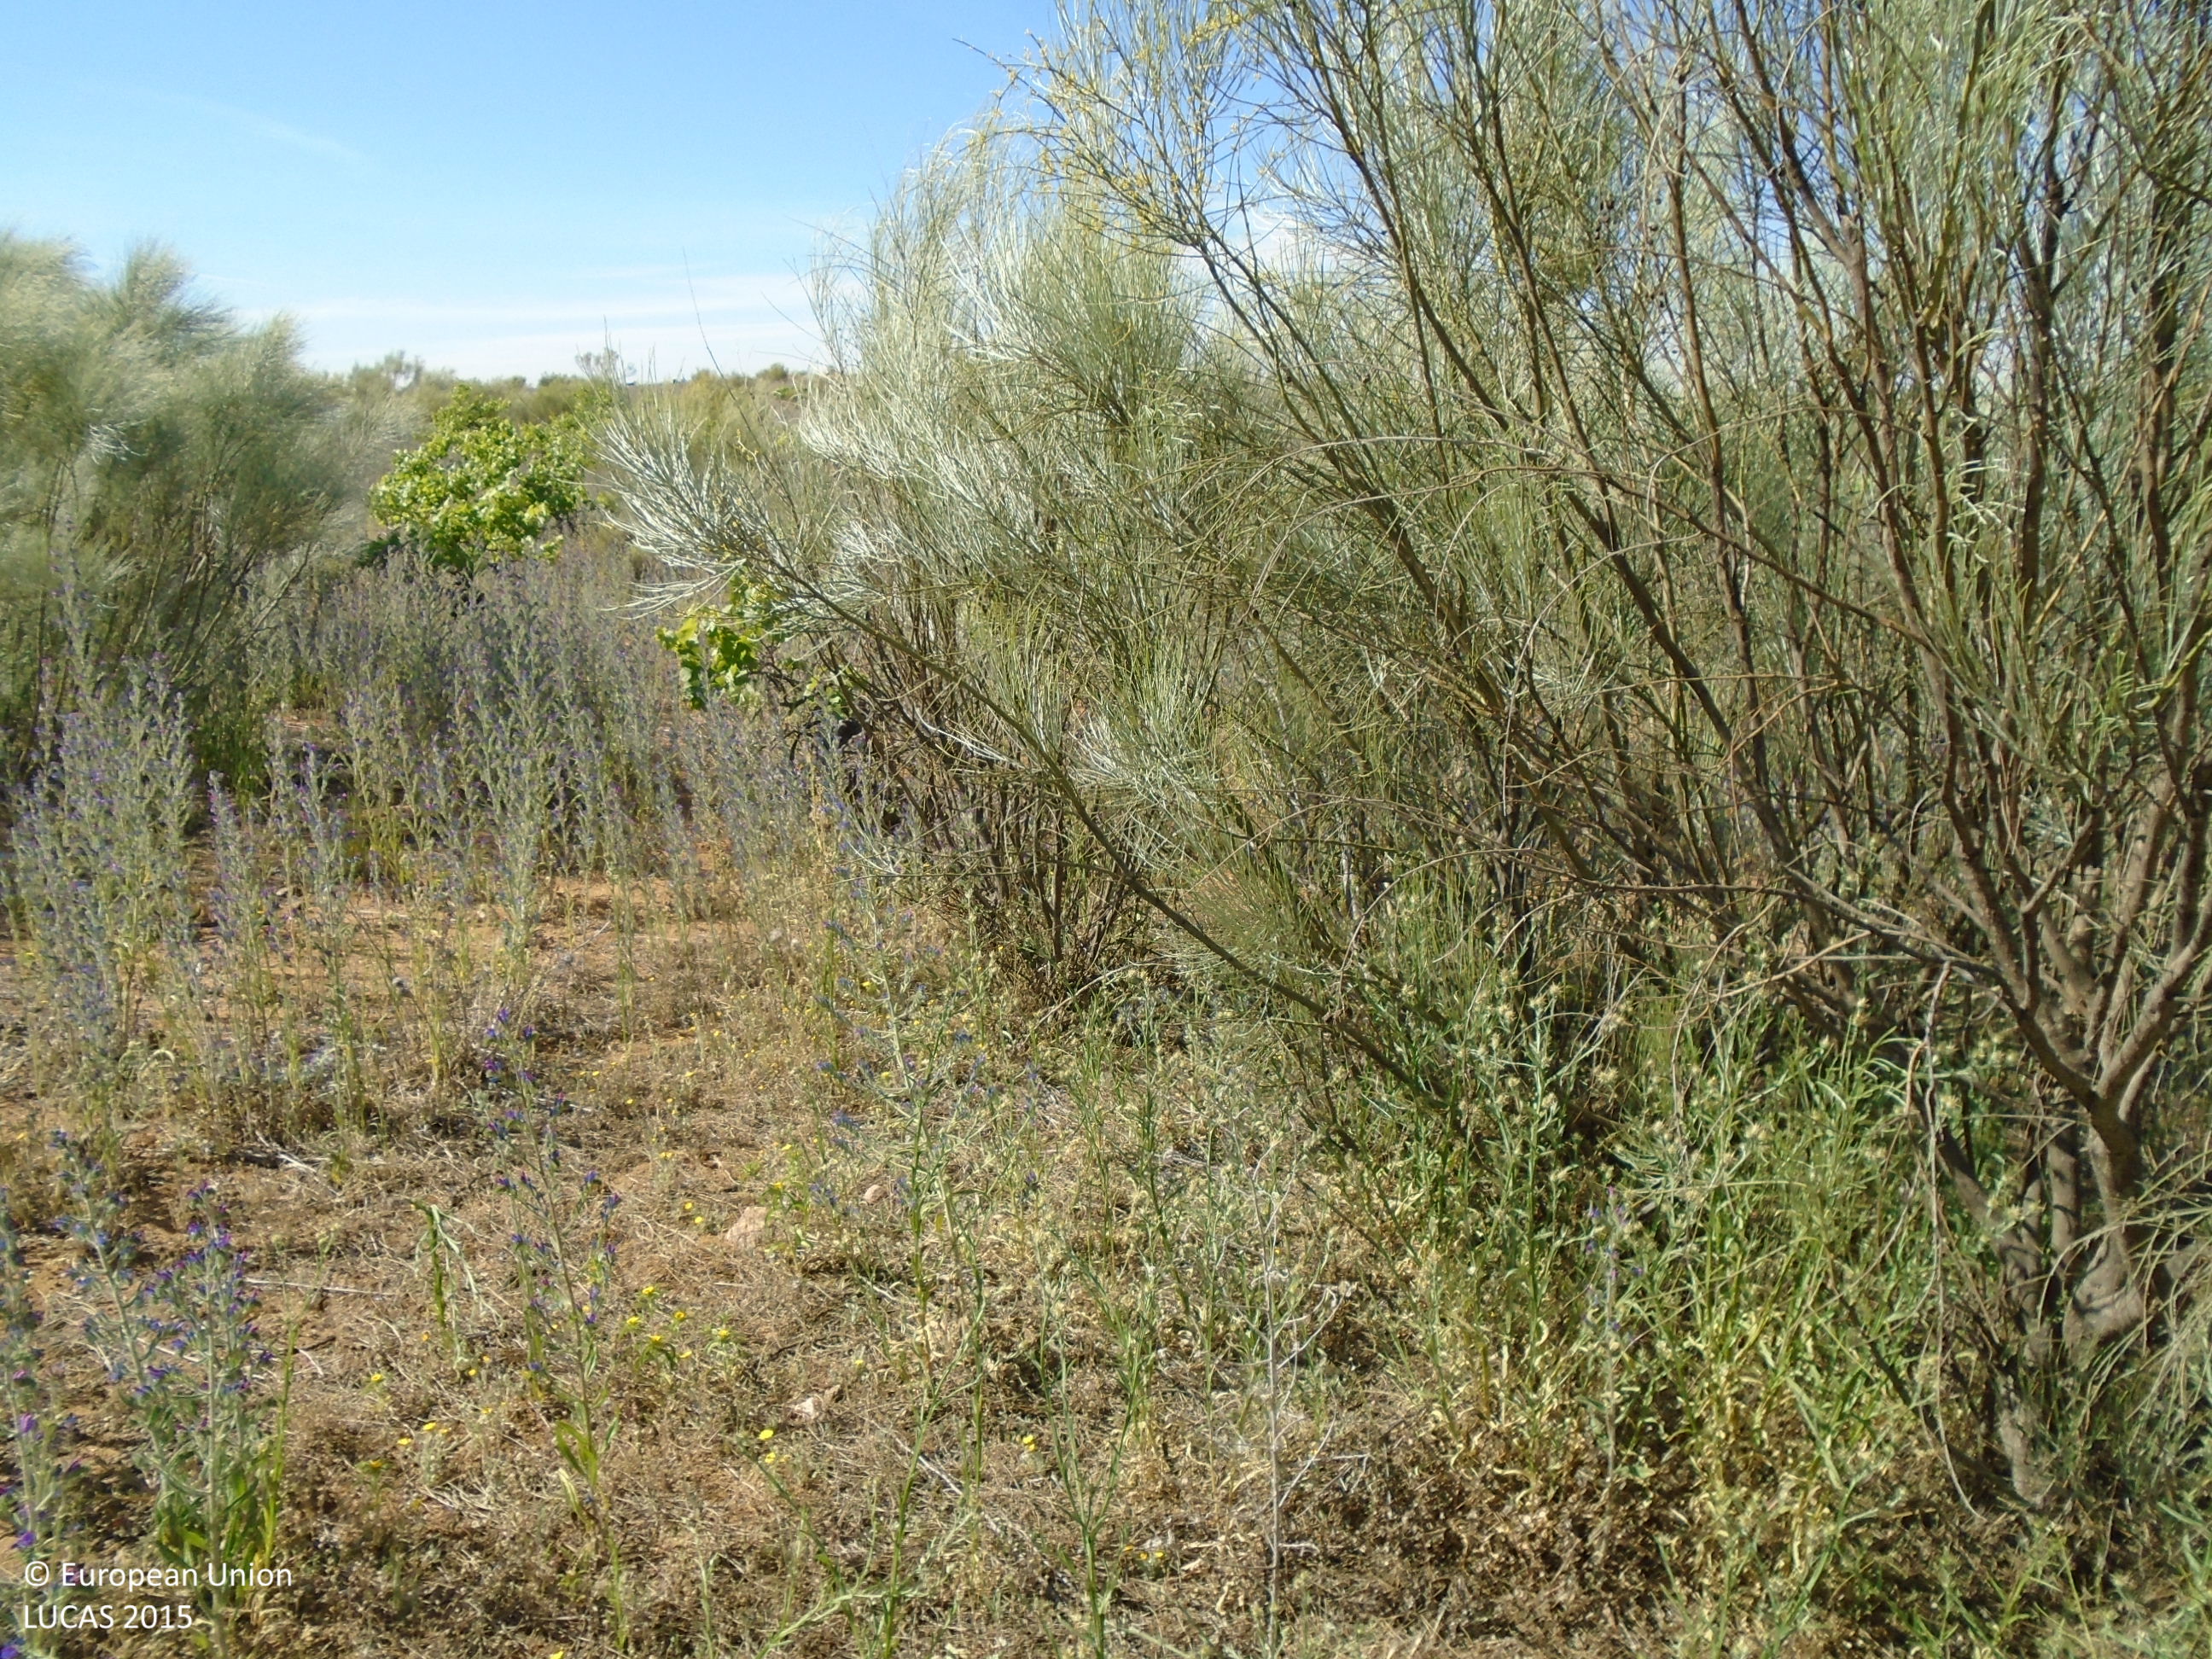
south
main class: Cropland
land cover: Vineyards
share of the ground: 10 - 25 %
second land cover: Shrubland without tree cover
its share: 25 - 50 %
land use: Abandoned areas
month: May
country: ES
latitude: 39.7743
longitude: -3.7239
